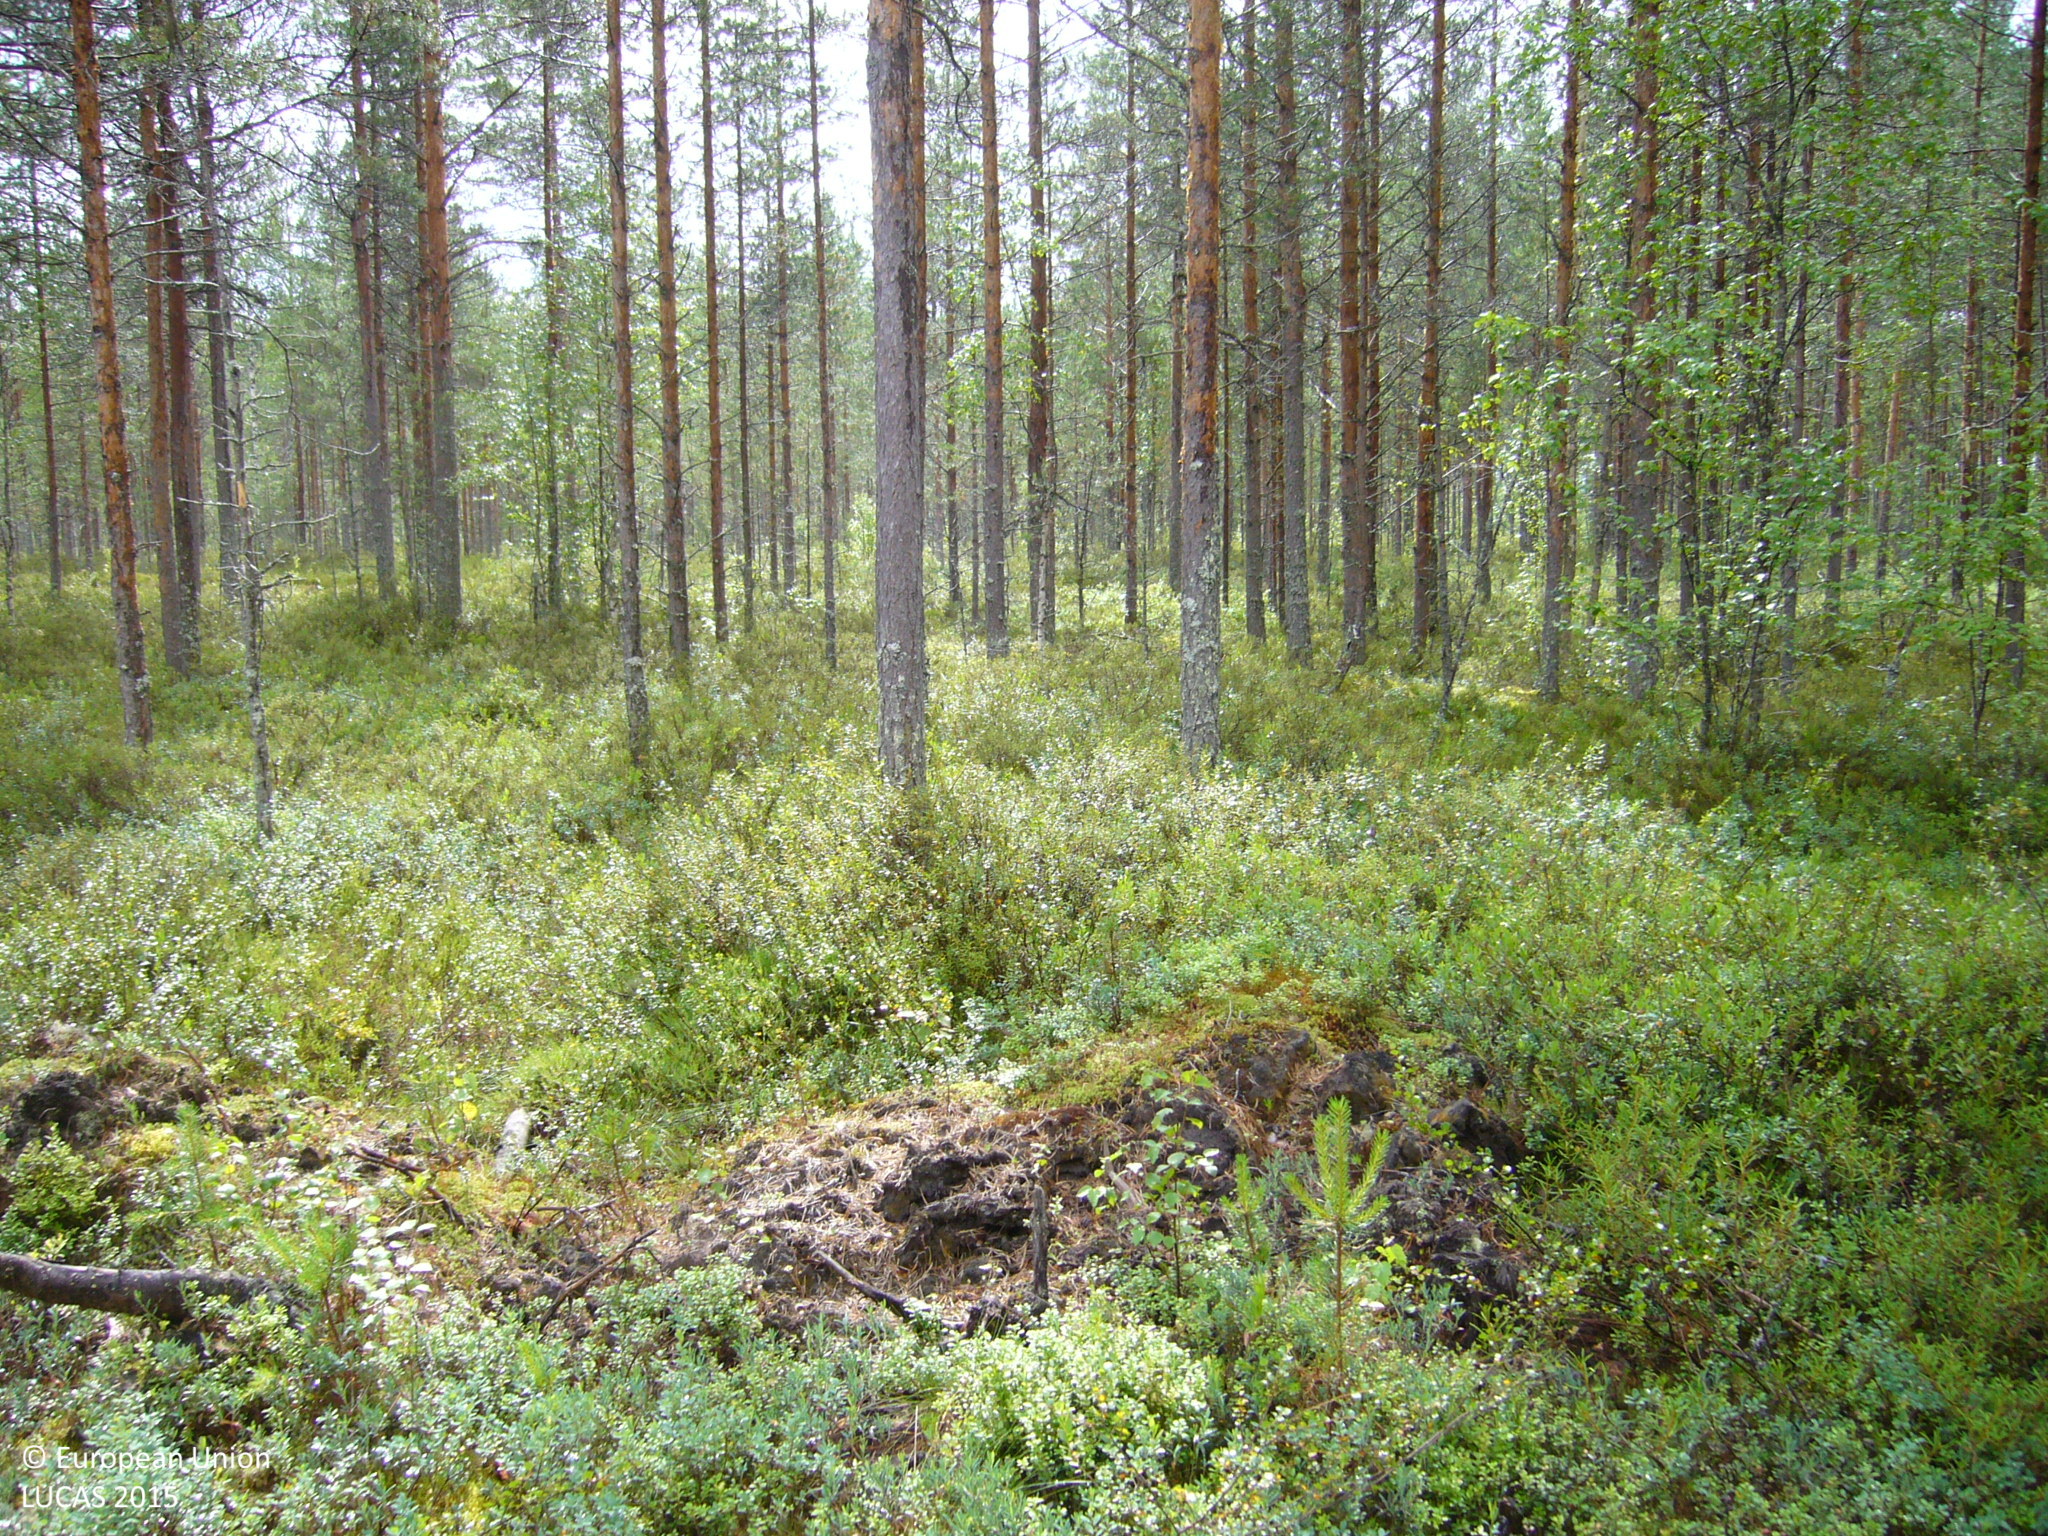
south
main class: Woodland
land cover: Pine dominated coniferous woodland
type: boreal forest
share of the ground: 50 - 75 %
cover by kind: coniferous forest trees 60 %, shrubs 40 %
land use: Forestry
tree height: > 5 m
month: July
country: FI
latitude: 63.7998
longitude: 26.0058
